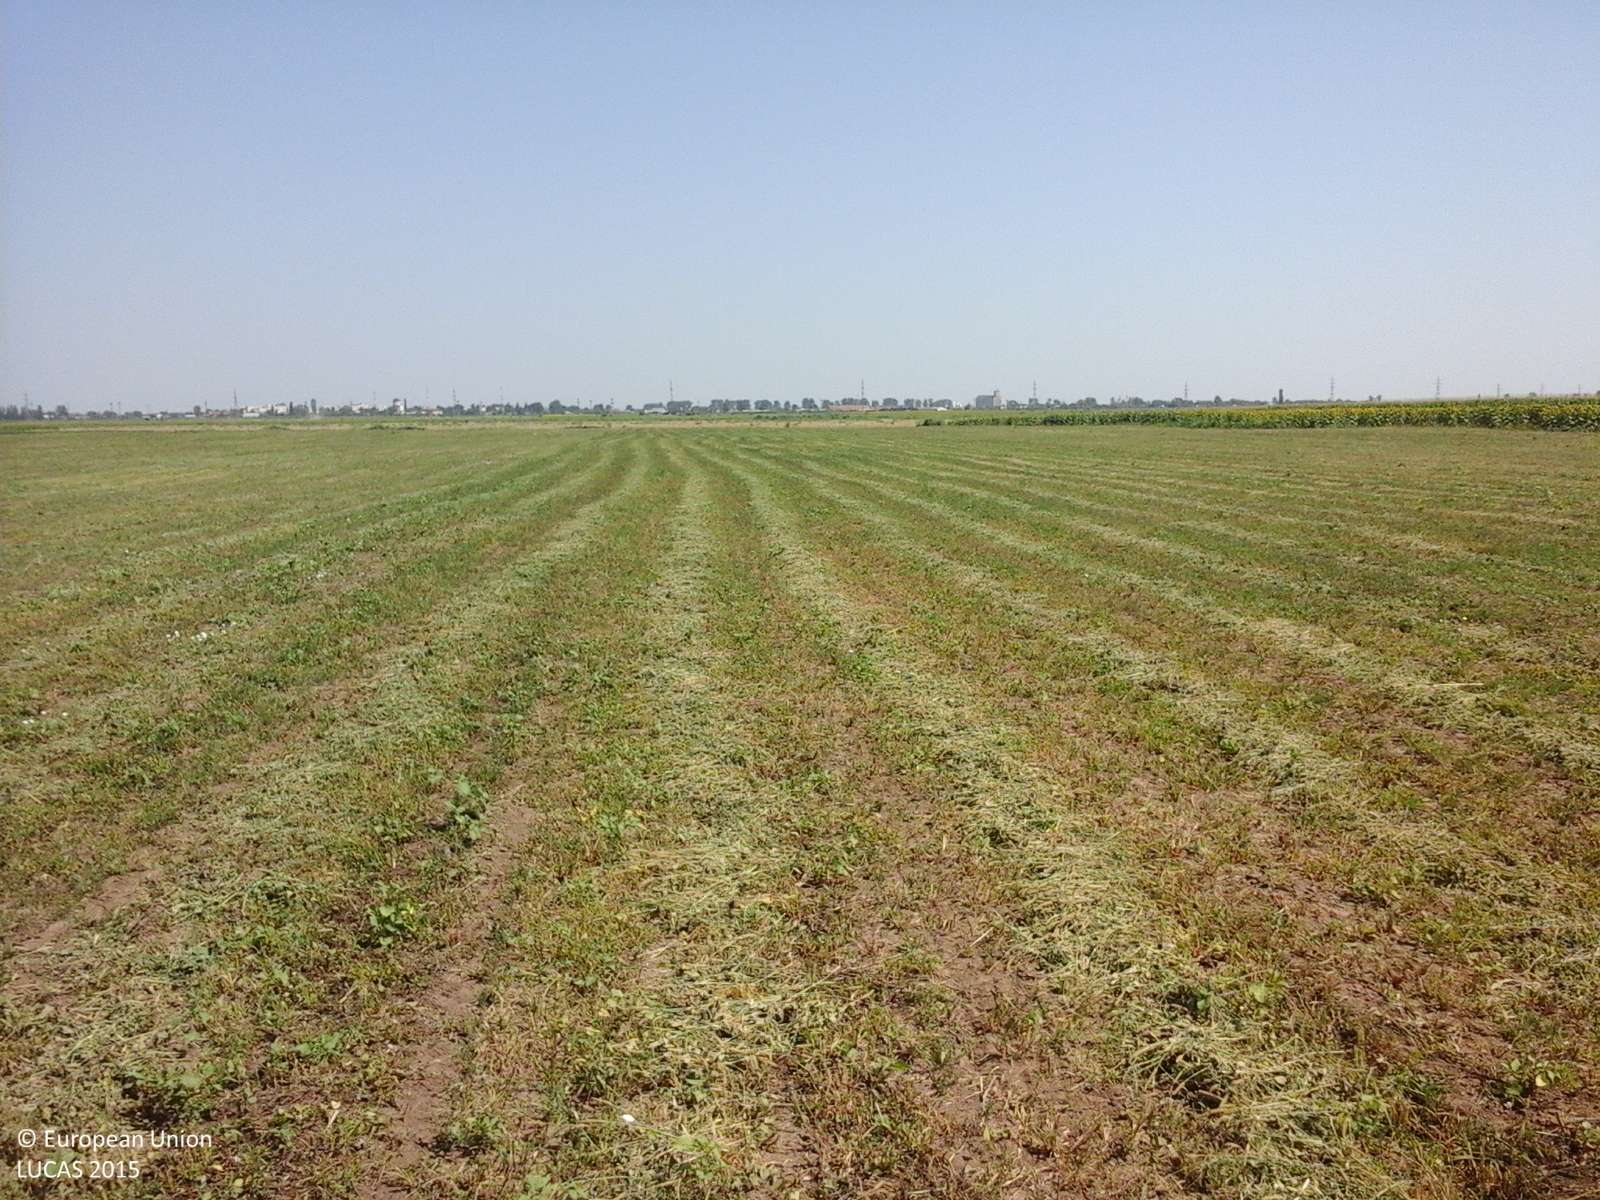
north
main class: Cropland
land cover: Lucerne
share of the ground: 25 - 50 %
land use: Agriculture (excluding fallow land and kitchen gardens)
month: July
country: RO
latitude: 45.0609
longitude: 27.2738
